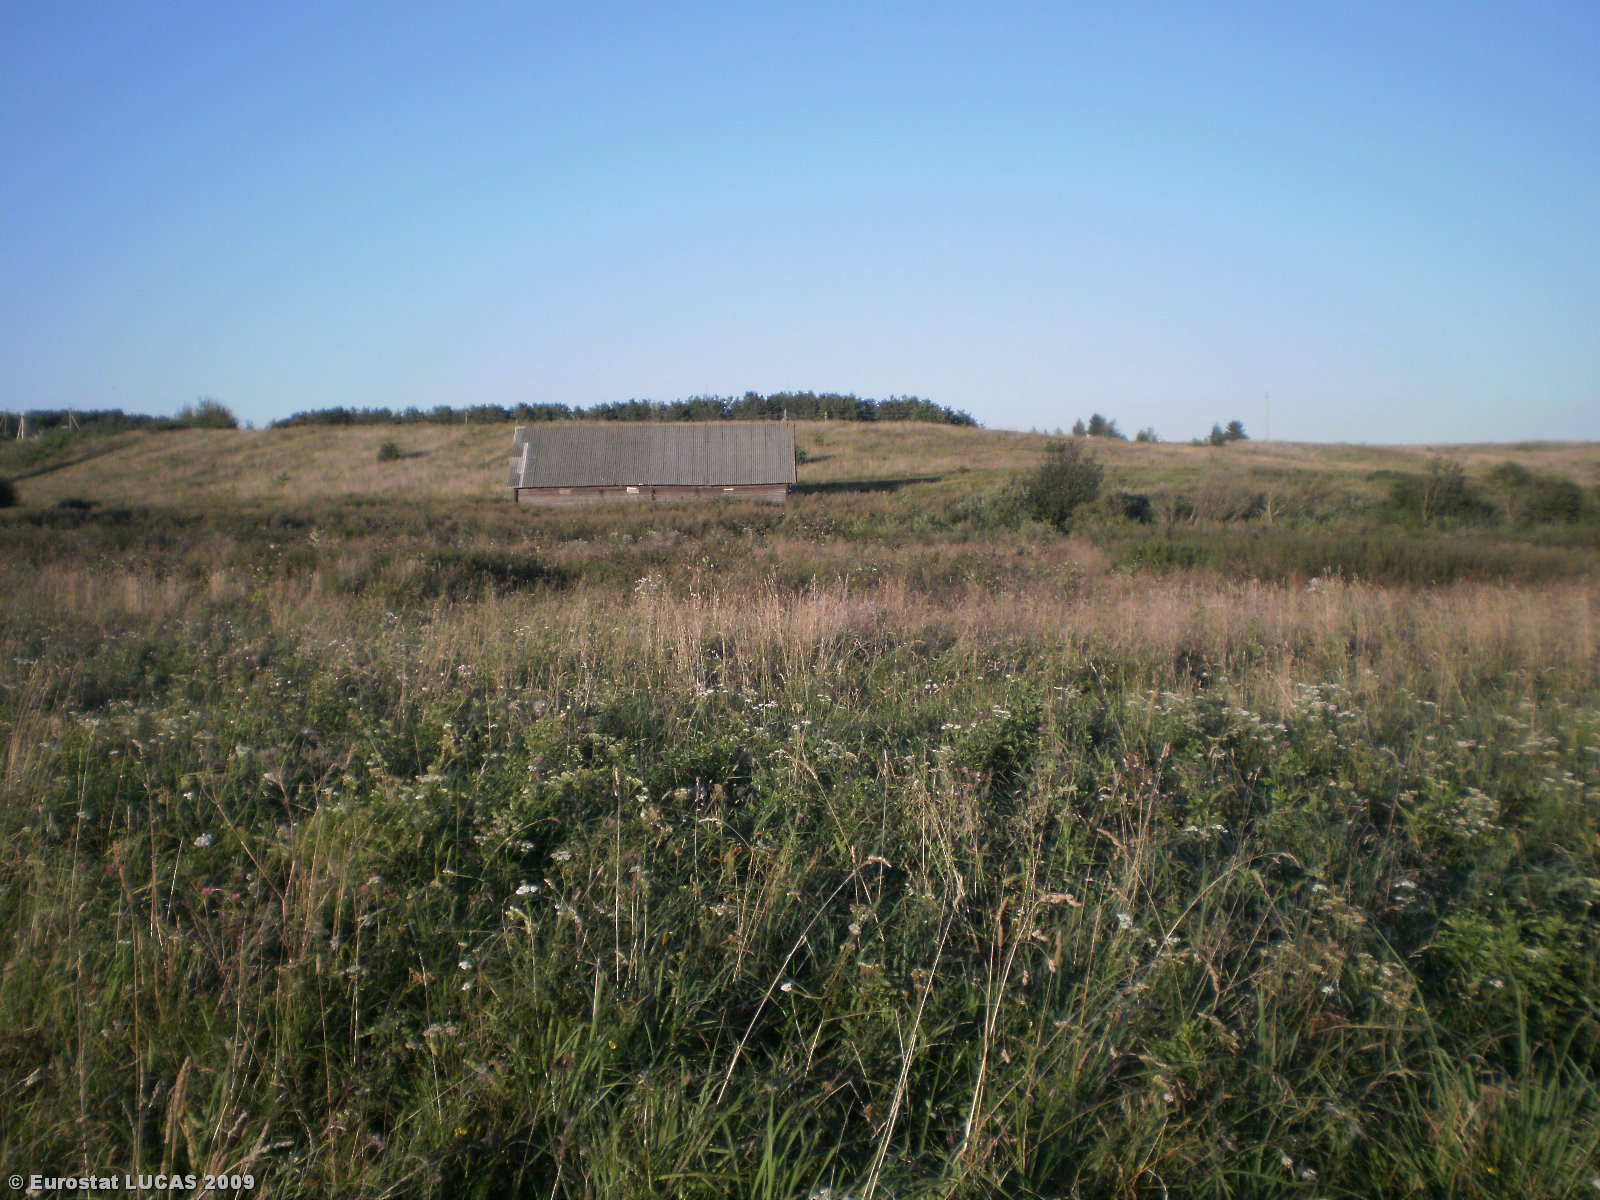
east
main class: Grassland
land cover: Grassland without tree/shrub cover
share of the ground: > 75 %
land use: Agriculture (excluding fallow land and kitchen gardens)
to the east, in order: Grassland without tree/shrub cover; Abandoned hedges; Ditches and canals; Abandoned hedges; Grassland without tree/shrub cover; Tracks; Grassland without tree/shrub cover; Paved roads, cycling and walking lanes; Grassland without tree/shrub cover
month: August
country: LT
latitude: 54.8726
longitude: 24.5811
